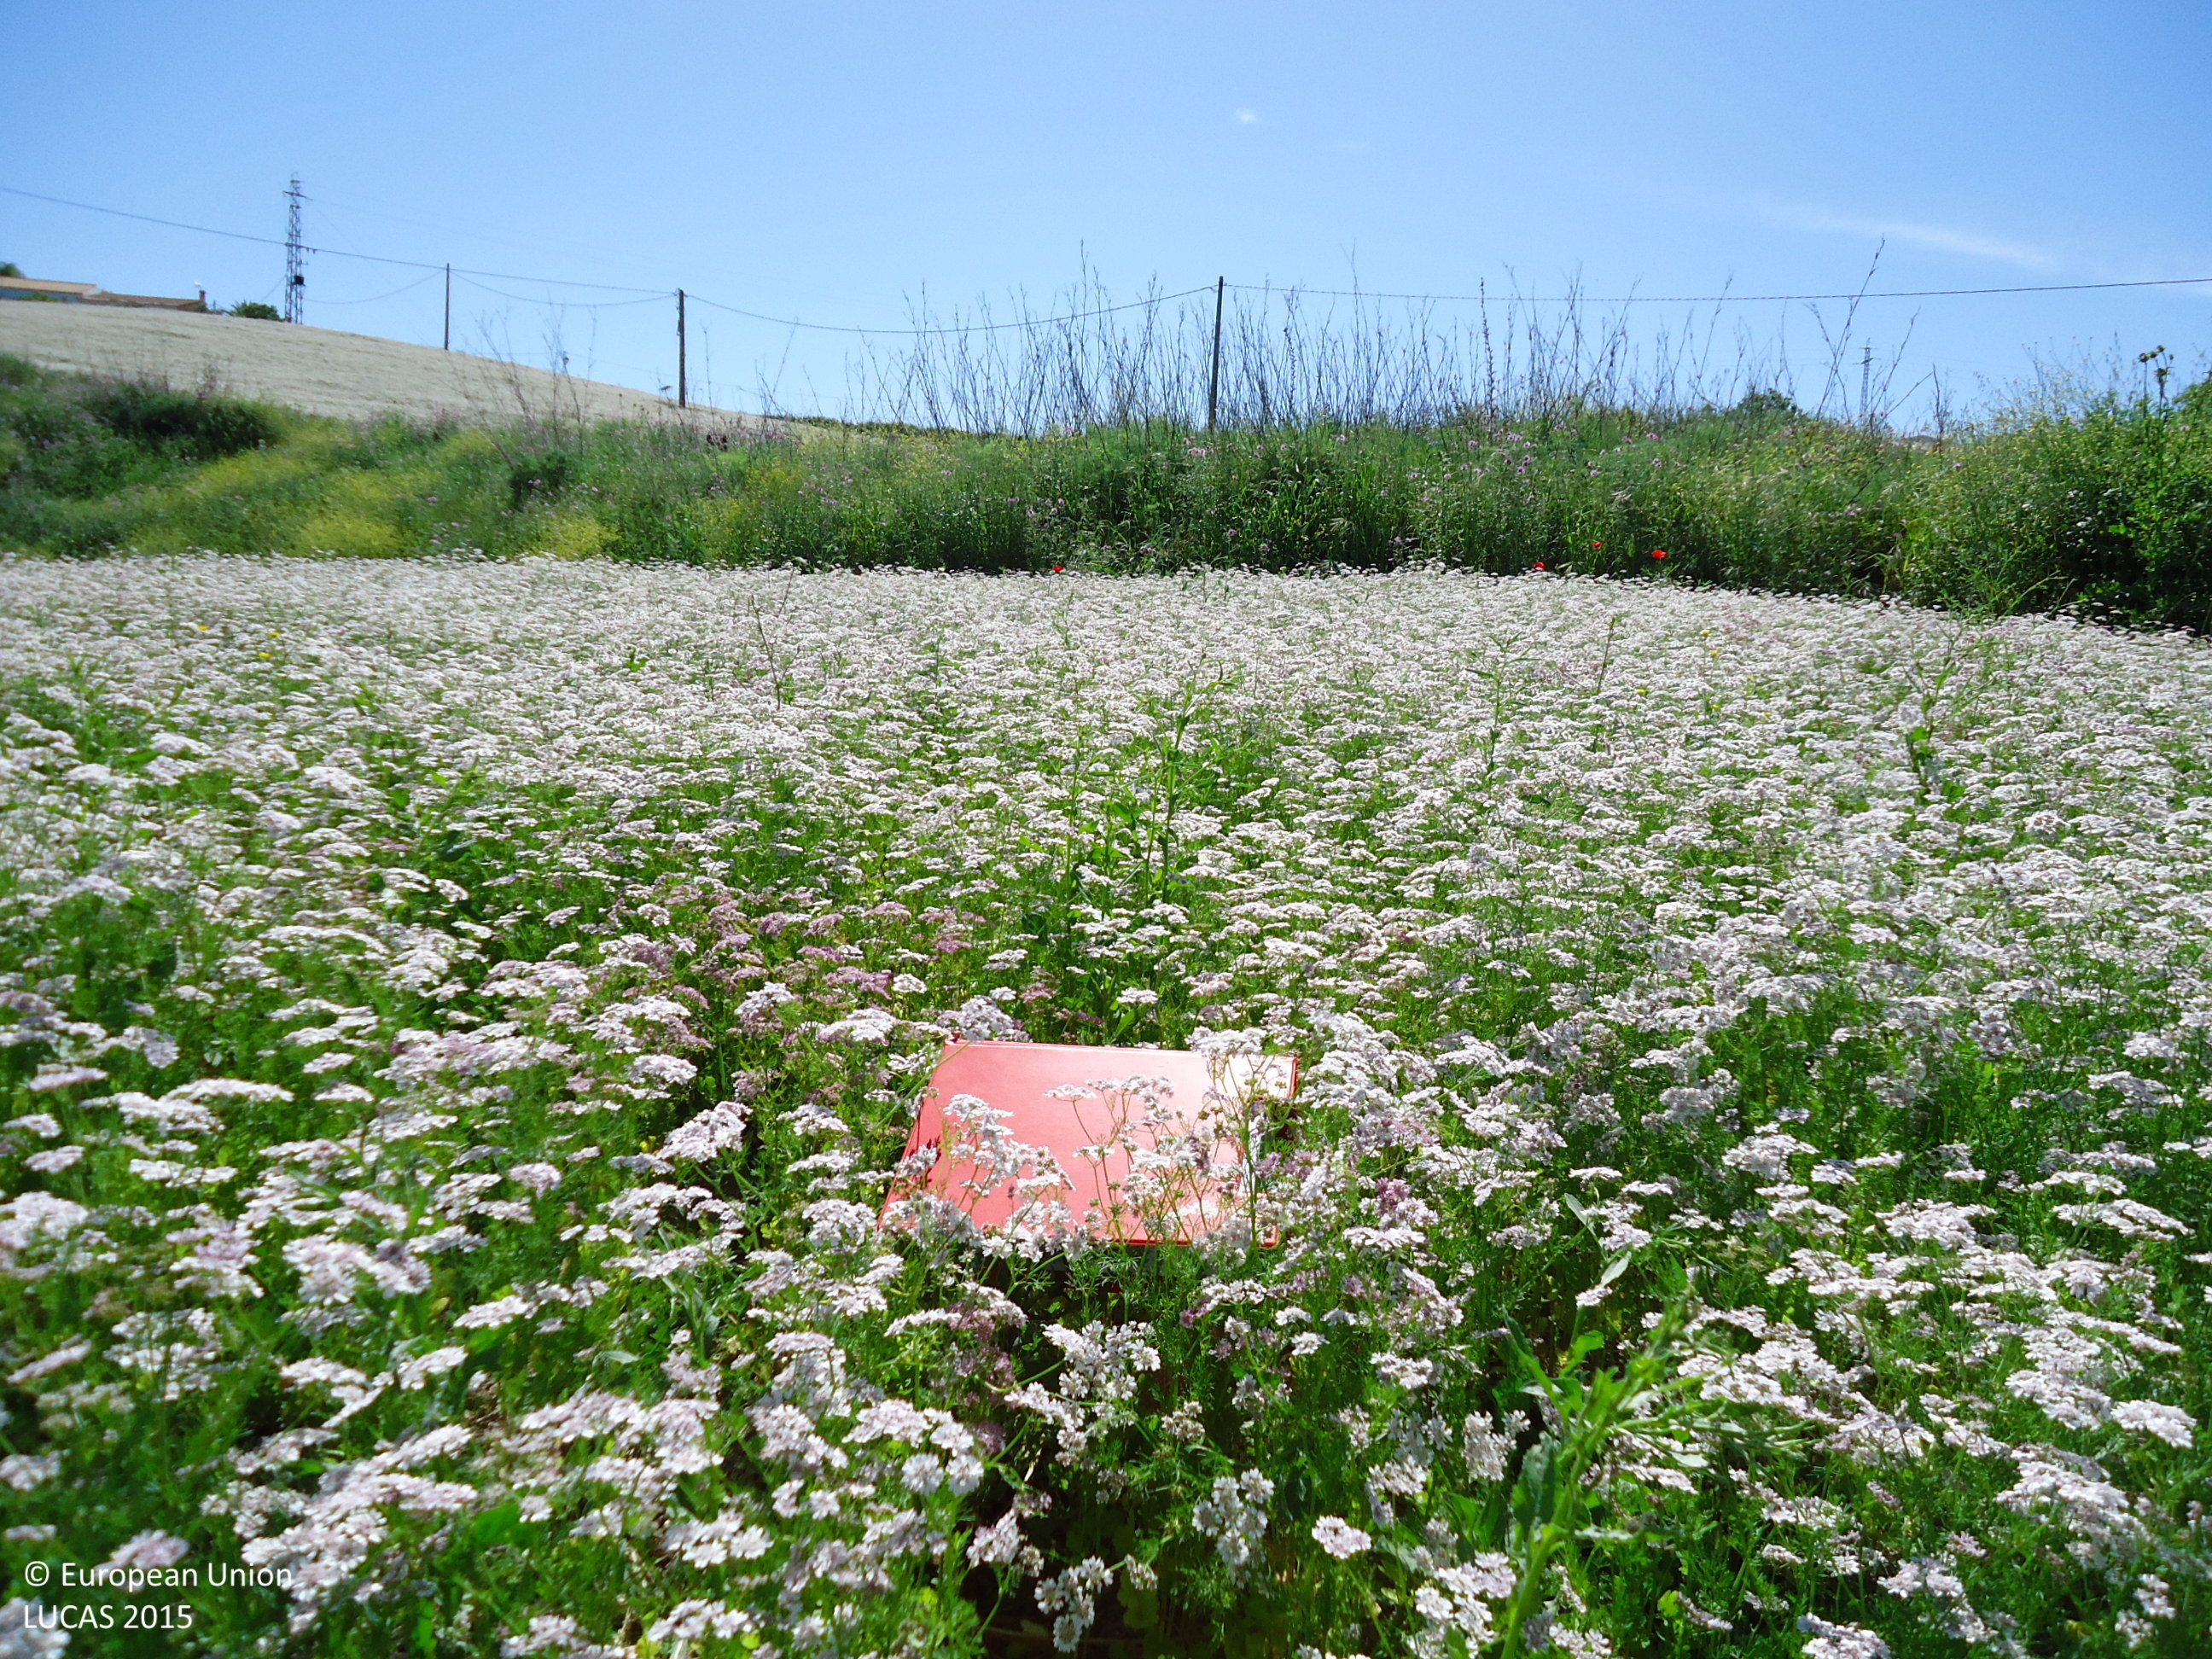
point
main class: Cropland
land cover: Other non-permanent industrial crops
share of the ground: > 75 %
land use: Agriculture (excluding fallow land and kitchen gardens)
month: May
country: ES
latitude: 36.8567
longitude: -5.2677
